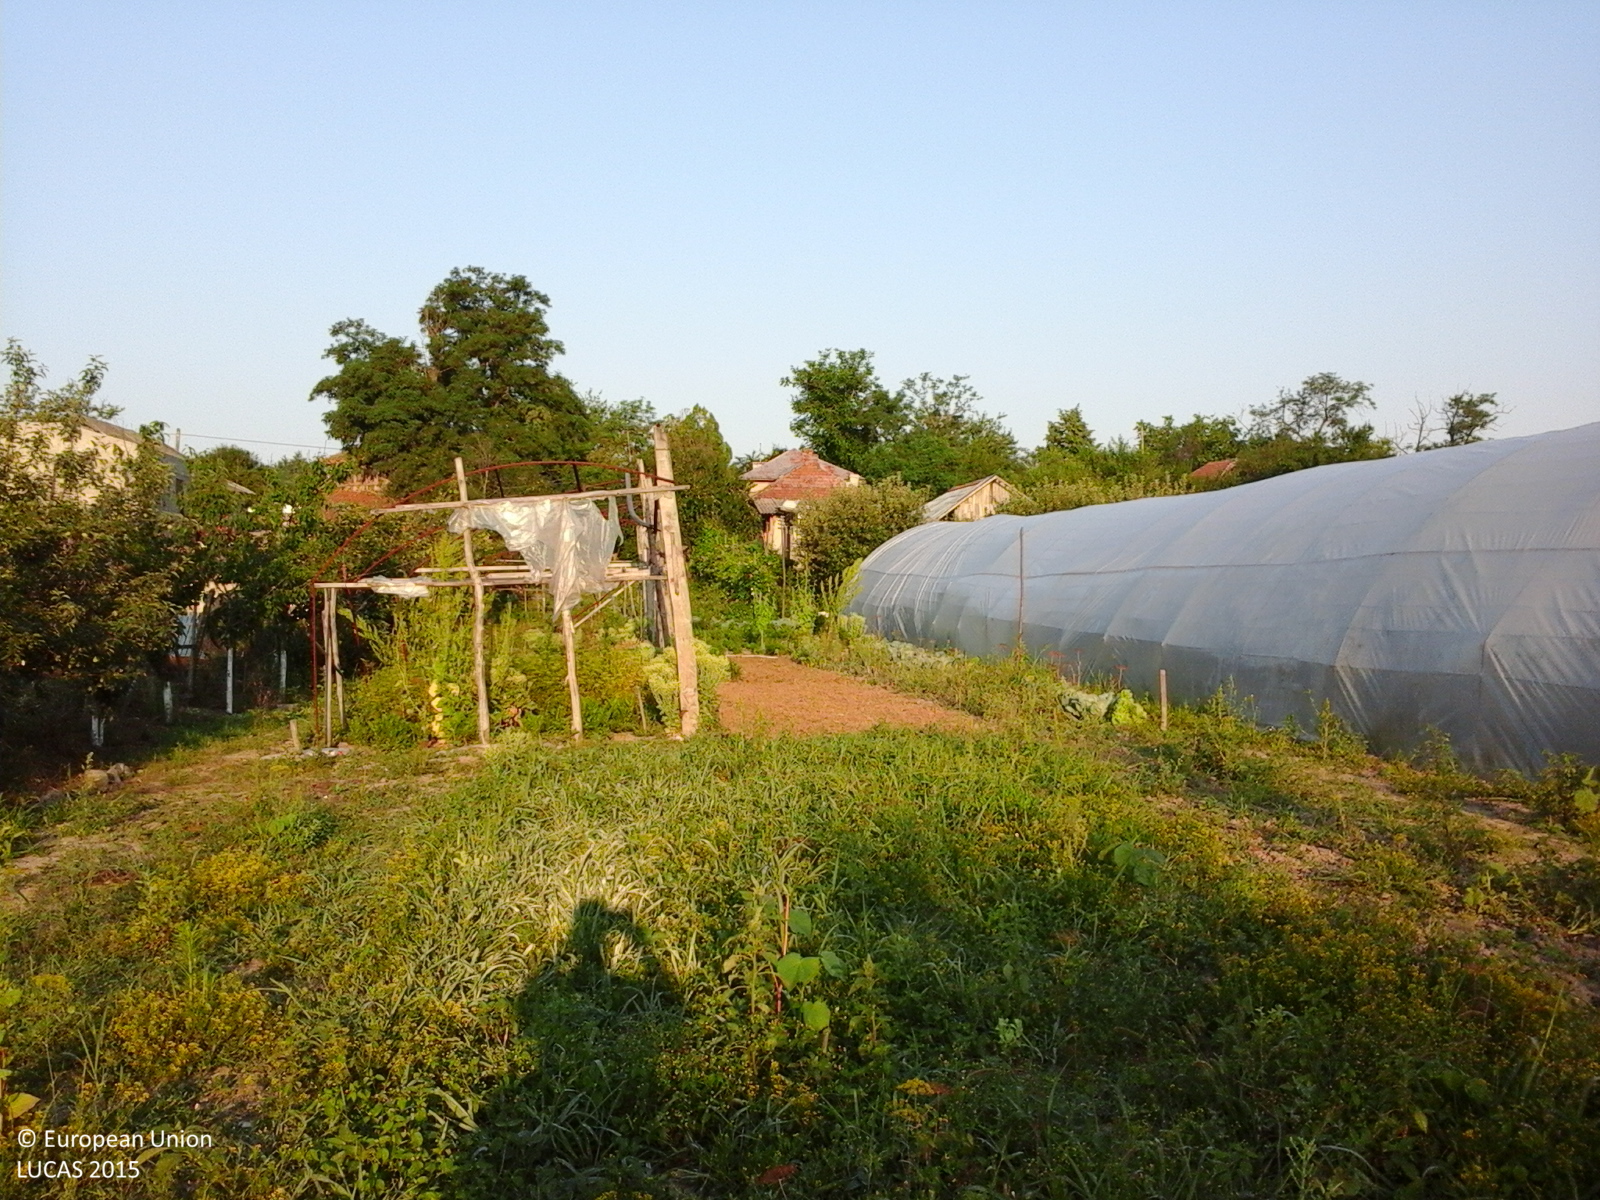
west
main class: Grassland
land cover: Spontaneously vegetated surfaces
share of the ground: 50 - 75 %
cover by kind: herbaceous plants 65 %, unconsolidated bare surface 35 %
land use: Agriculture (excluding fallow land and kitchen gardens)
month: July
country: RO
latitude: 44.5859
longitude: 24.6477
